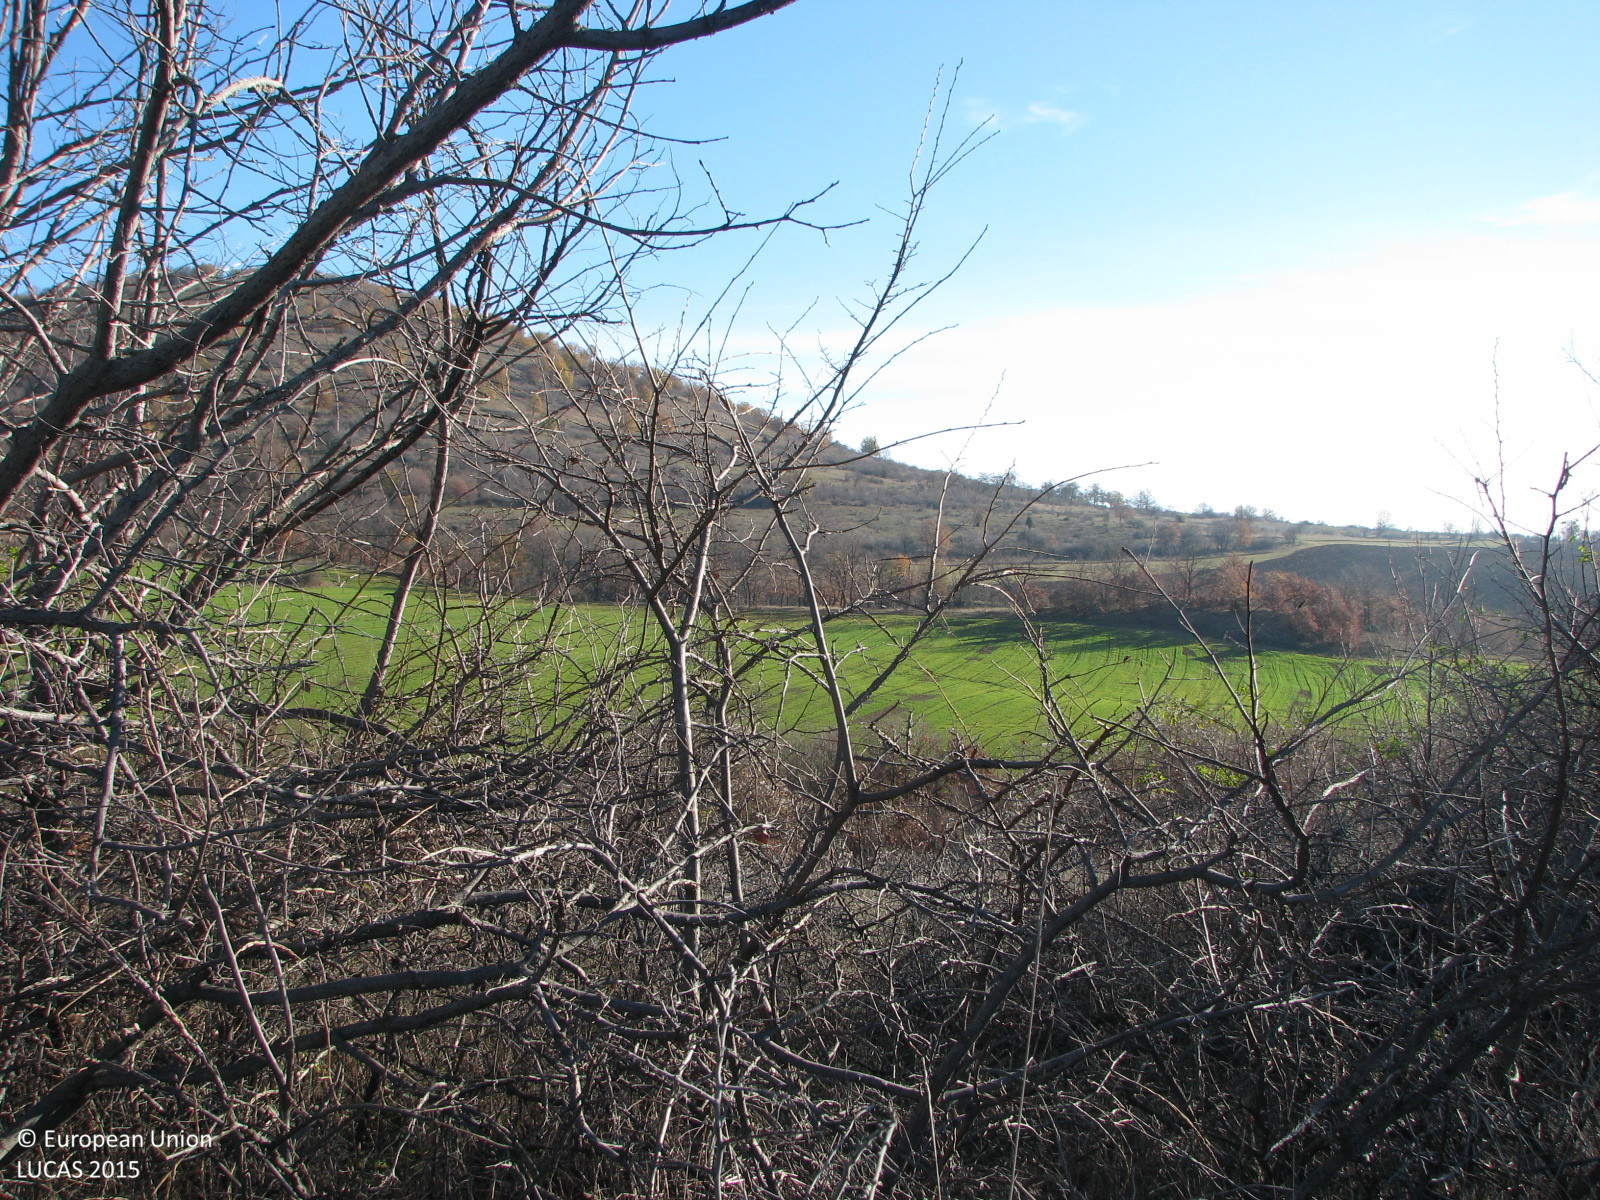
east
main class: Shrubland
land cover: Shrubland with sparse tree cover
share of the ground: 50 - 75 %
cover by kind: shrubs 60 %, herbaceous plants 35 %, broadleaved forest trees 5 %
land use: Semi-natural and natural areas not in use
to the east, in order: Shrubland with sparse tree cover; Grassland without tree/shrub cover; Broadleaved woodland; Rivers and streams; Broadleaved woodland; Common wheat; Broadleaved woodland
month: December
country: BG
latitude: 42.4449
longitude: 24.2588
